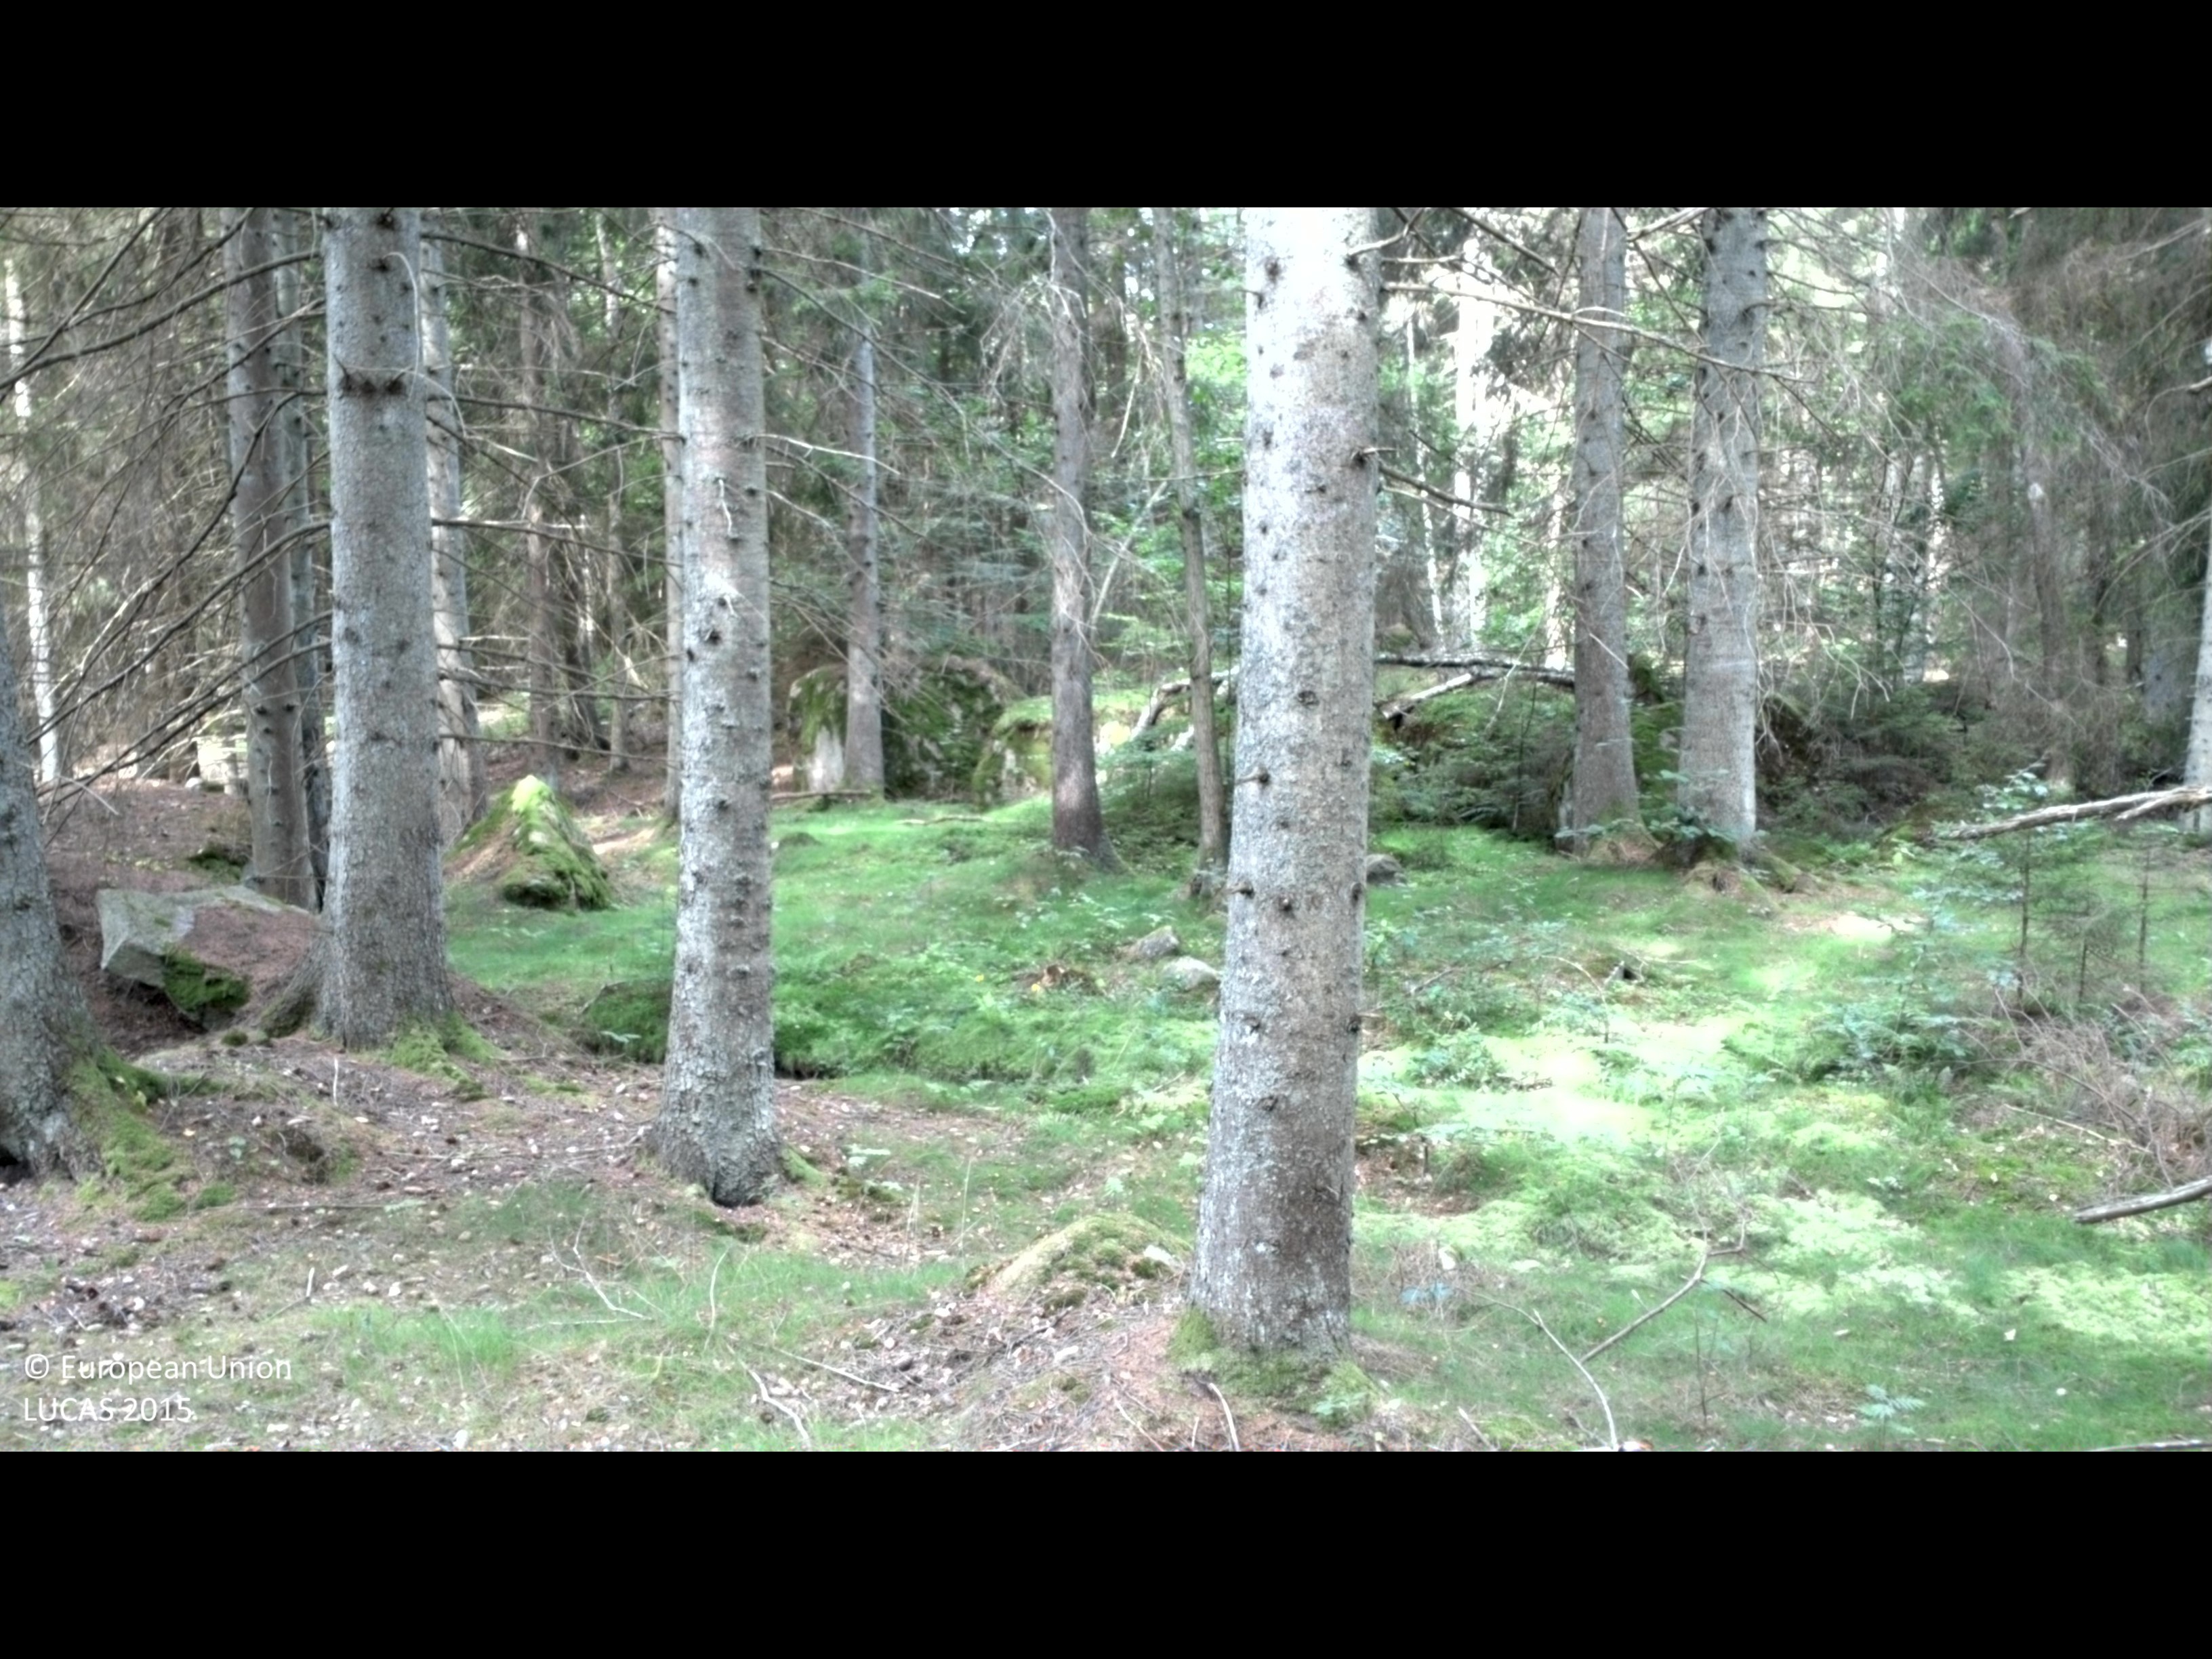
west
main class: Woodland
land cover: Spruce dominated coniferous woodland
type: boreal forest
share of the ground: 50 - 75 %
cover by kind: coniferous forest trees 55 %, lichens and mosses 35 %, broadleaved forest trees 5 %, herbaceous plants 5 %
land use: Forestry
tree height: > 5 m
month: August
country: SE
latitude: 56.3060
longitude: 15.8674
